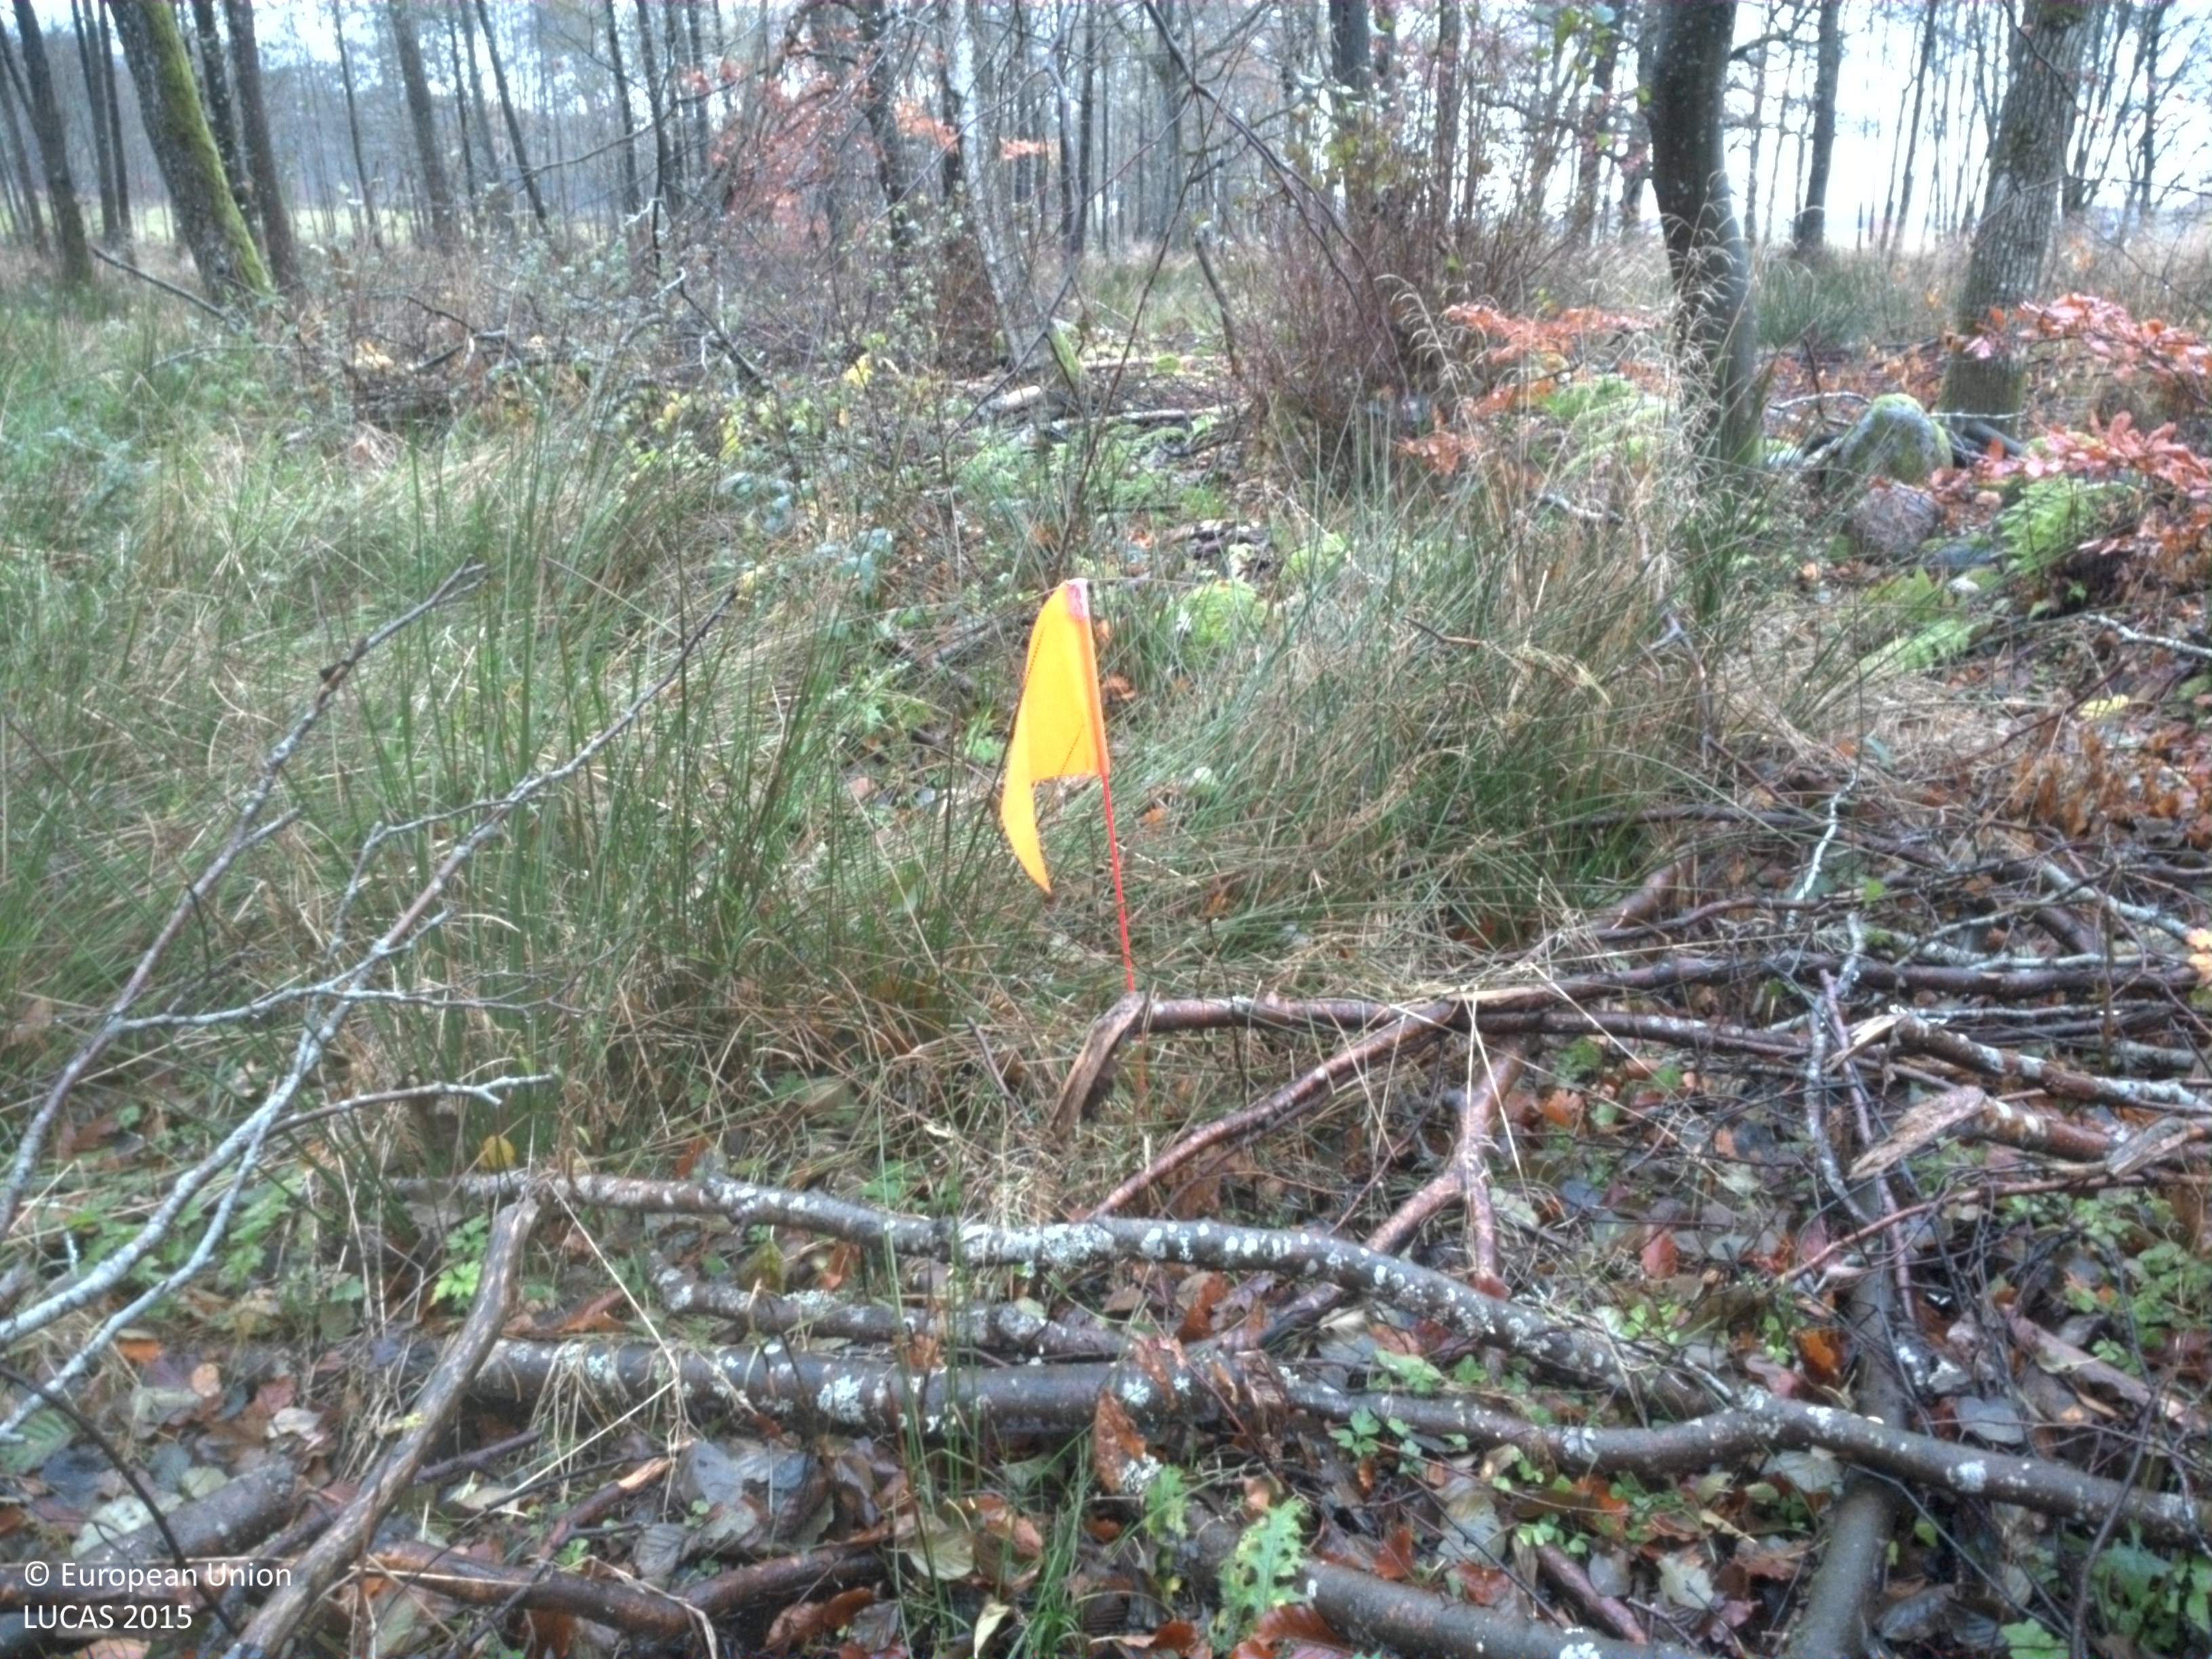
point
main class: Woodland
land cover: Broadleaved woodland
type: hemiboreal forest and nemoral coniferous forest and mixed broadleaved-coniferous forest
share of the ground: 50 - 75 %
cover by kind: broadleaved forest trees 55 %, herbaceous plants 35 %, shrubs 10 %
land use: Forestry
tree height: > 5 m
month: November
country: SE
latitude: 56.0769
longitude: 13.1626
